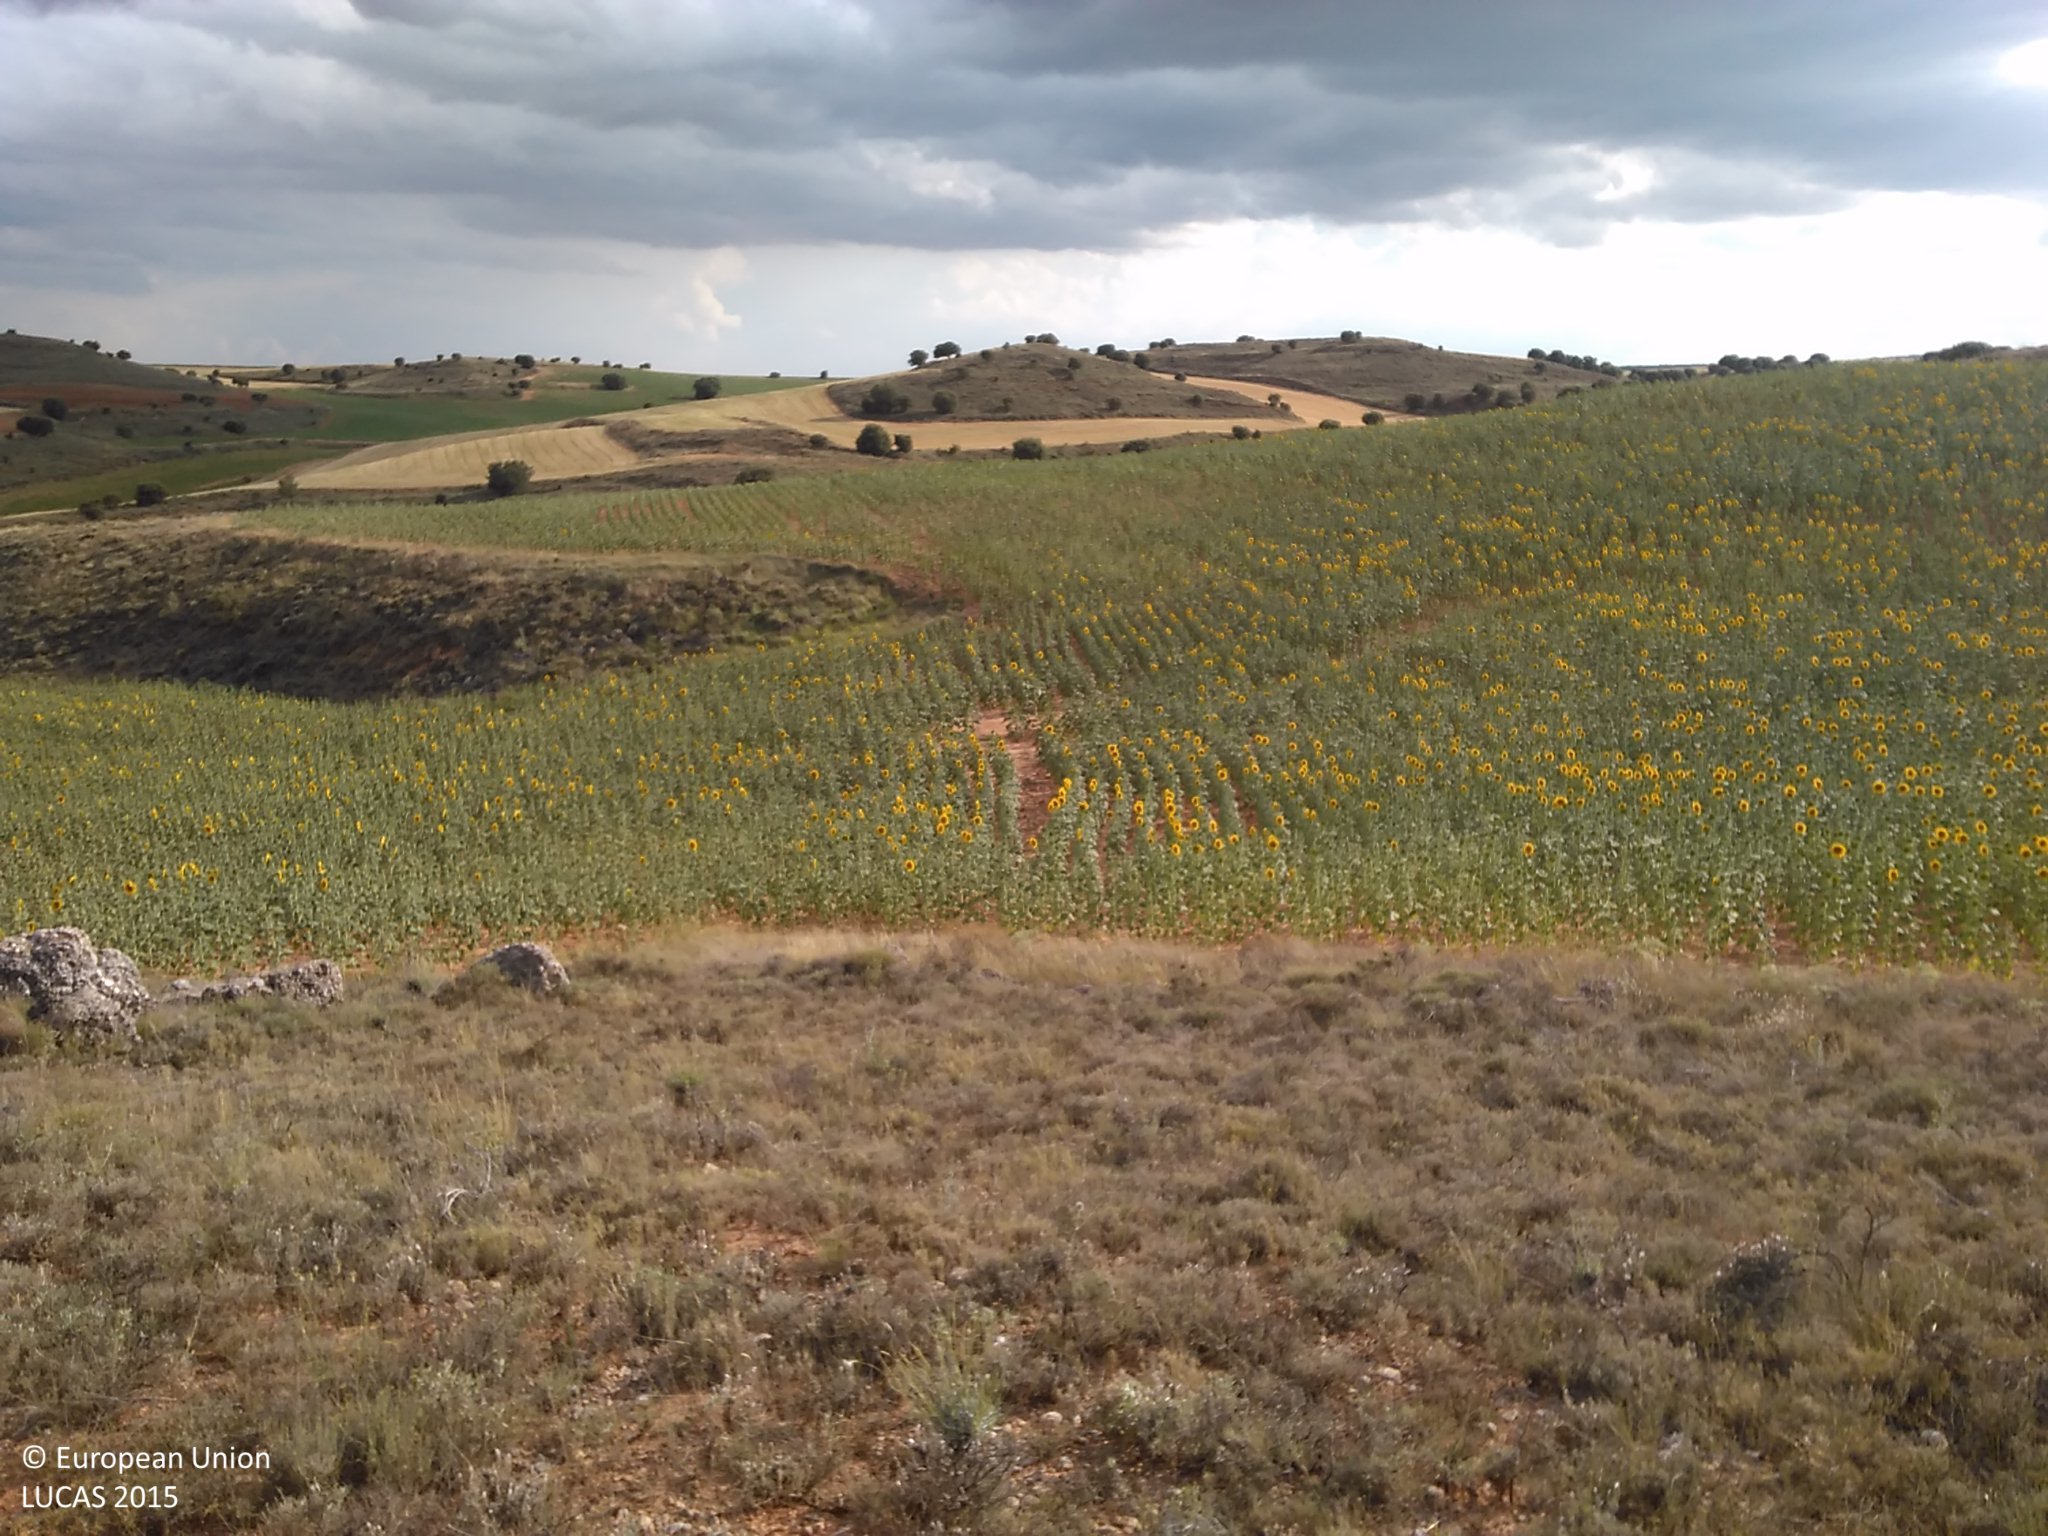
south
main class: Shrubland
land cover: Shrubland without tree cover
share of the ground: 50 - 75 %
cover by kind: shrubs 60 %, unconsolidated bare surface 30 %, herbaceous plants 10 %
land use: Semi-natural and natural areas not in use
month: July
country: ES
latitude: 41.4743
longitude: -2.2104
